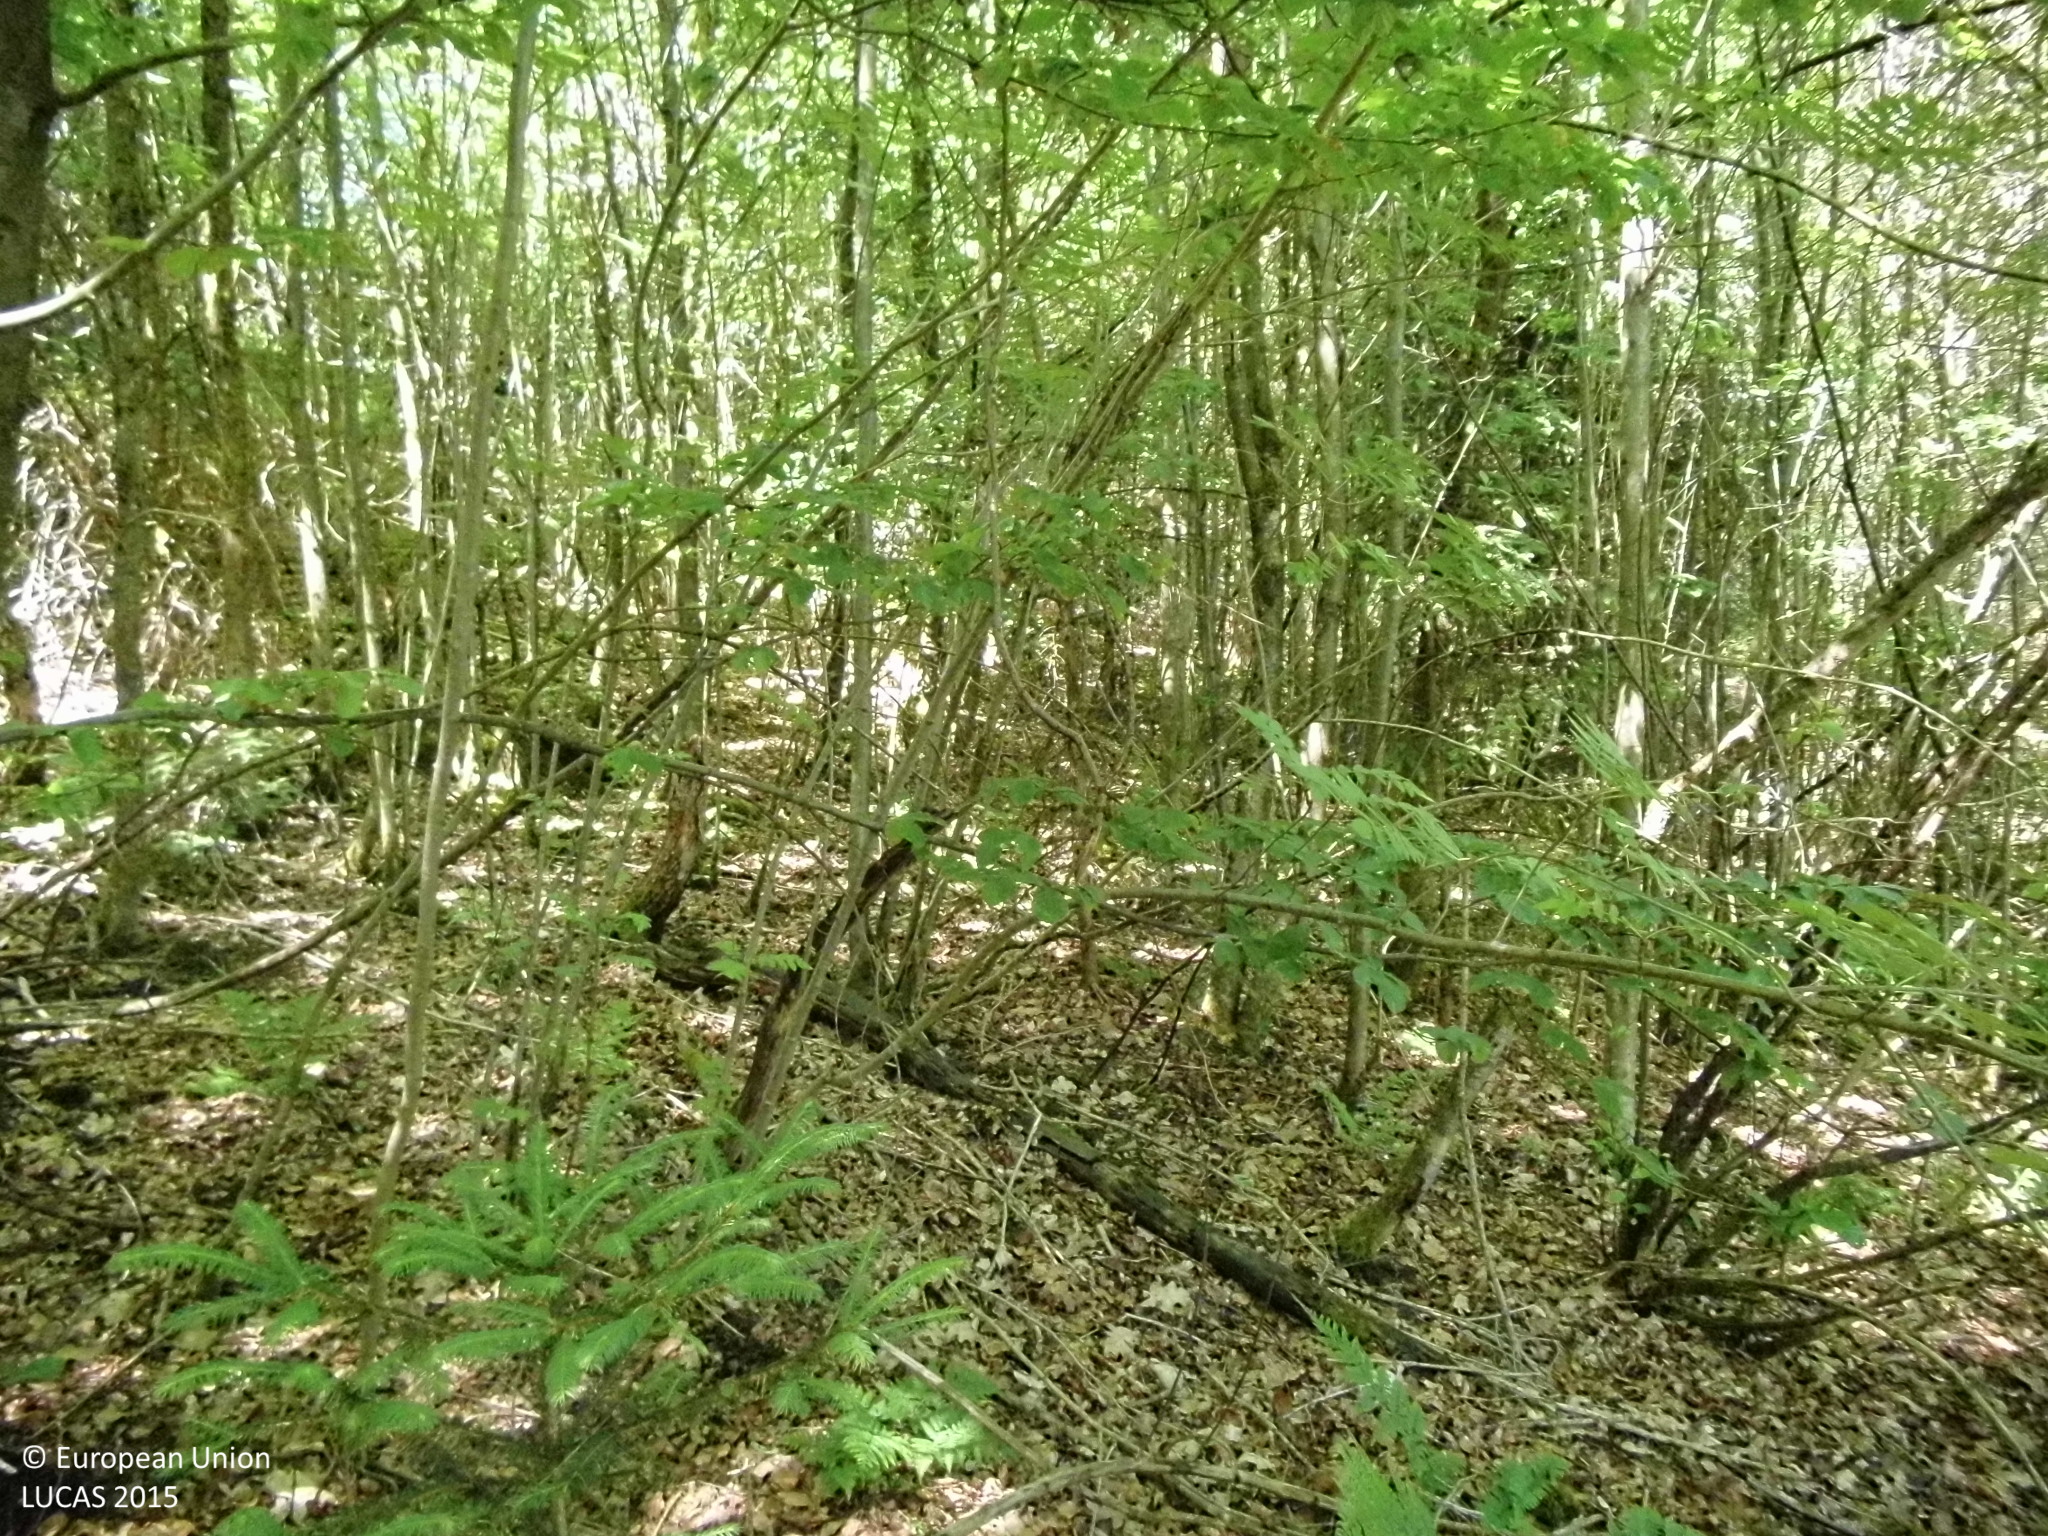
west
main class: Woodland
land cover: Broadleaved woodland
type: mesophytic deciduous forest
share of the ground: > 75 %
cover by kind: broadleaved forest trees 85 %, coniferous forest trees 15 %
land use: Forestry
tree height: > 5 m
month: June
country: DE
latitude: 50.9220
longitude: 7.9945
